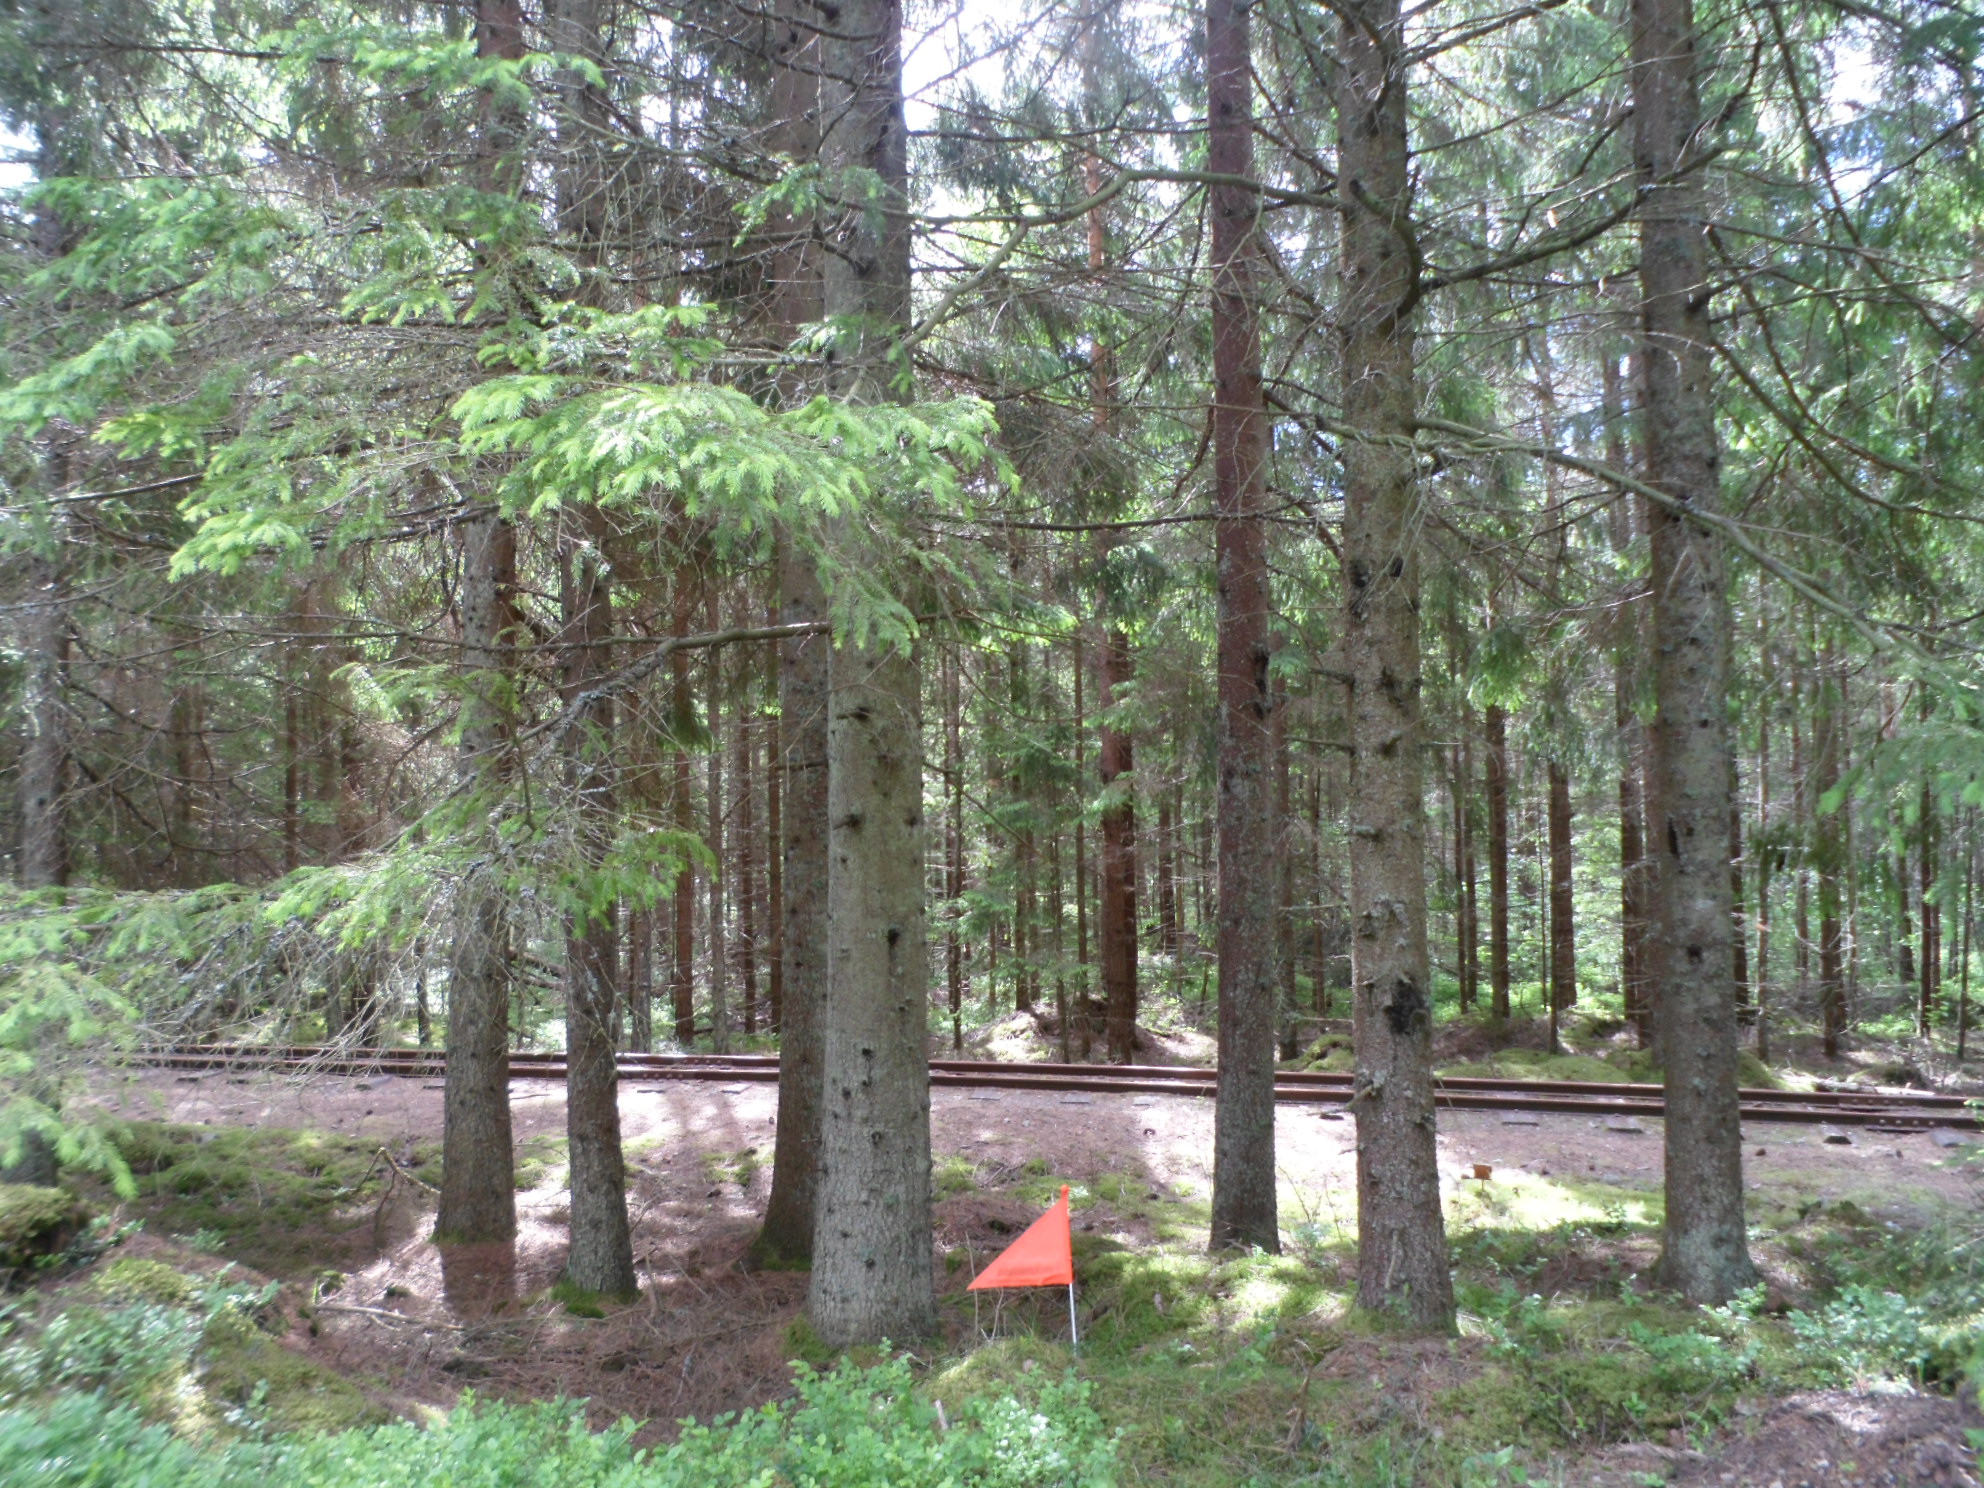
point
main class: Woodland
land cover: Spruce dominated coniferous woodland
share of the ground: 50 - 75 %
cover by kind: coniferous forest trees 60 %, lichens and mosses 15 %, shrubs 10 %, unconsolidated bare surface 10 %, herbaceous plants 5 %
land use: Forestry
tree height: > 5 m
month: June
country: SE
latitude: 57.1450
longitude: 14.2106
